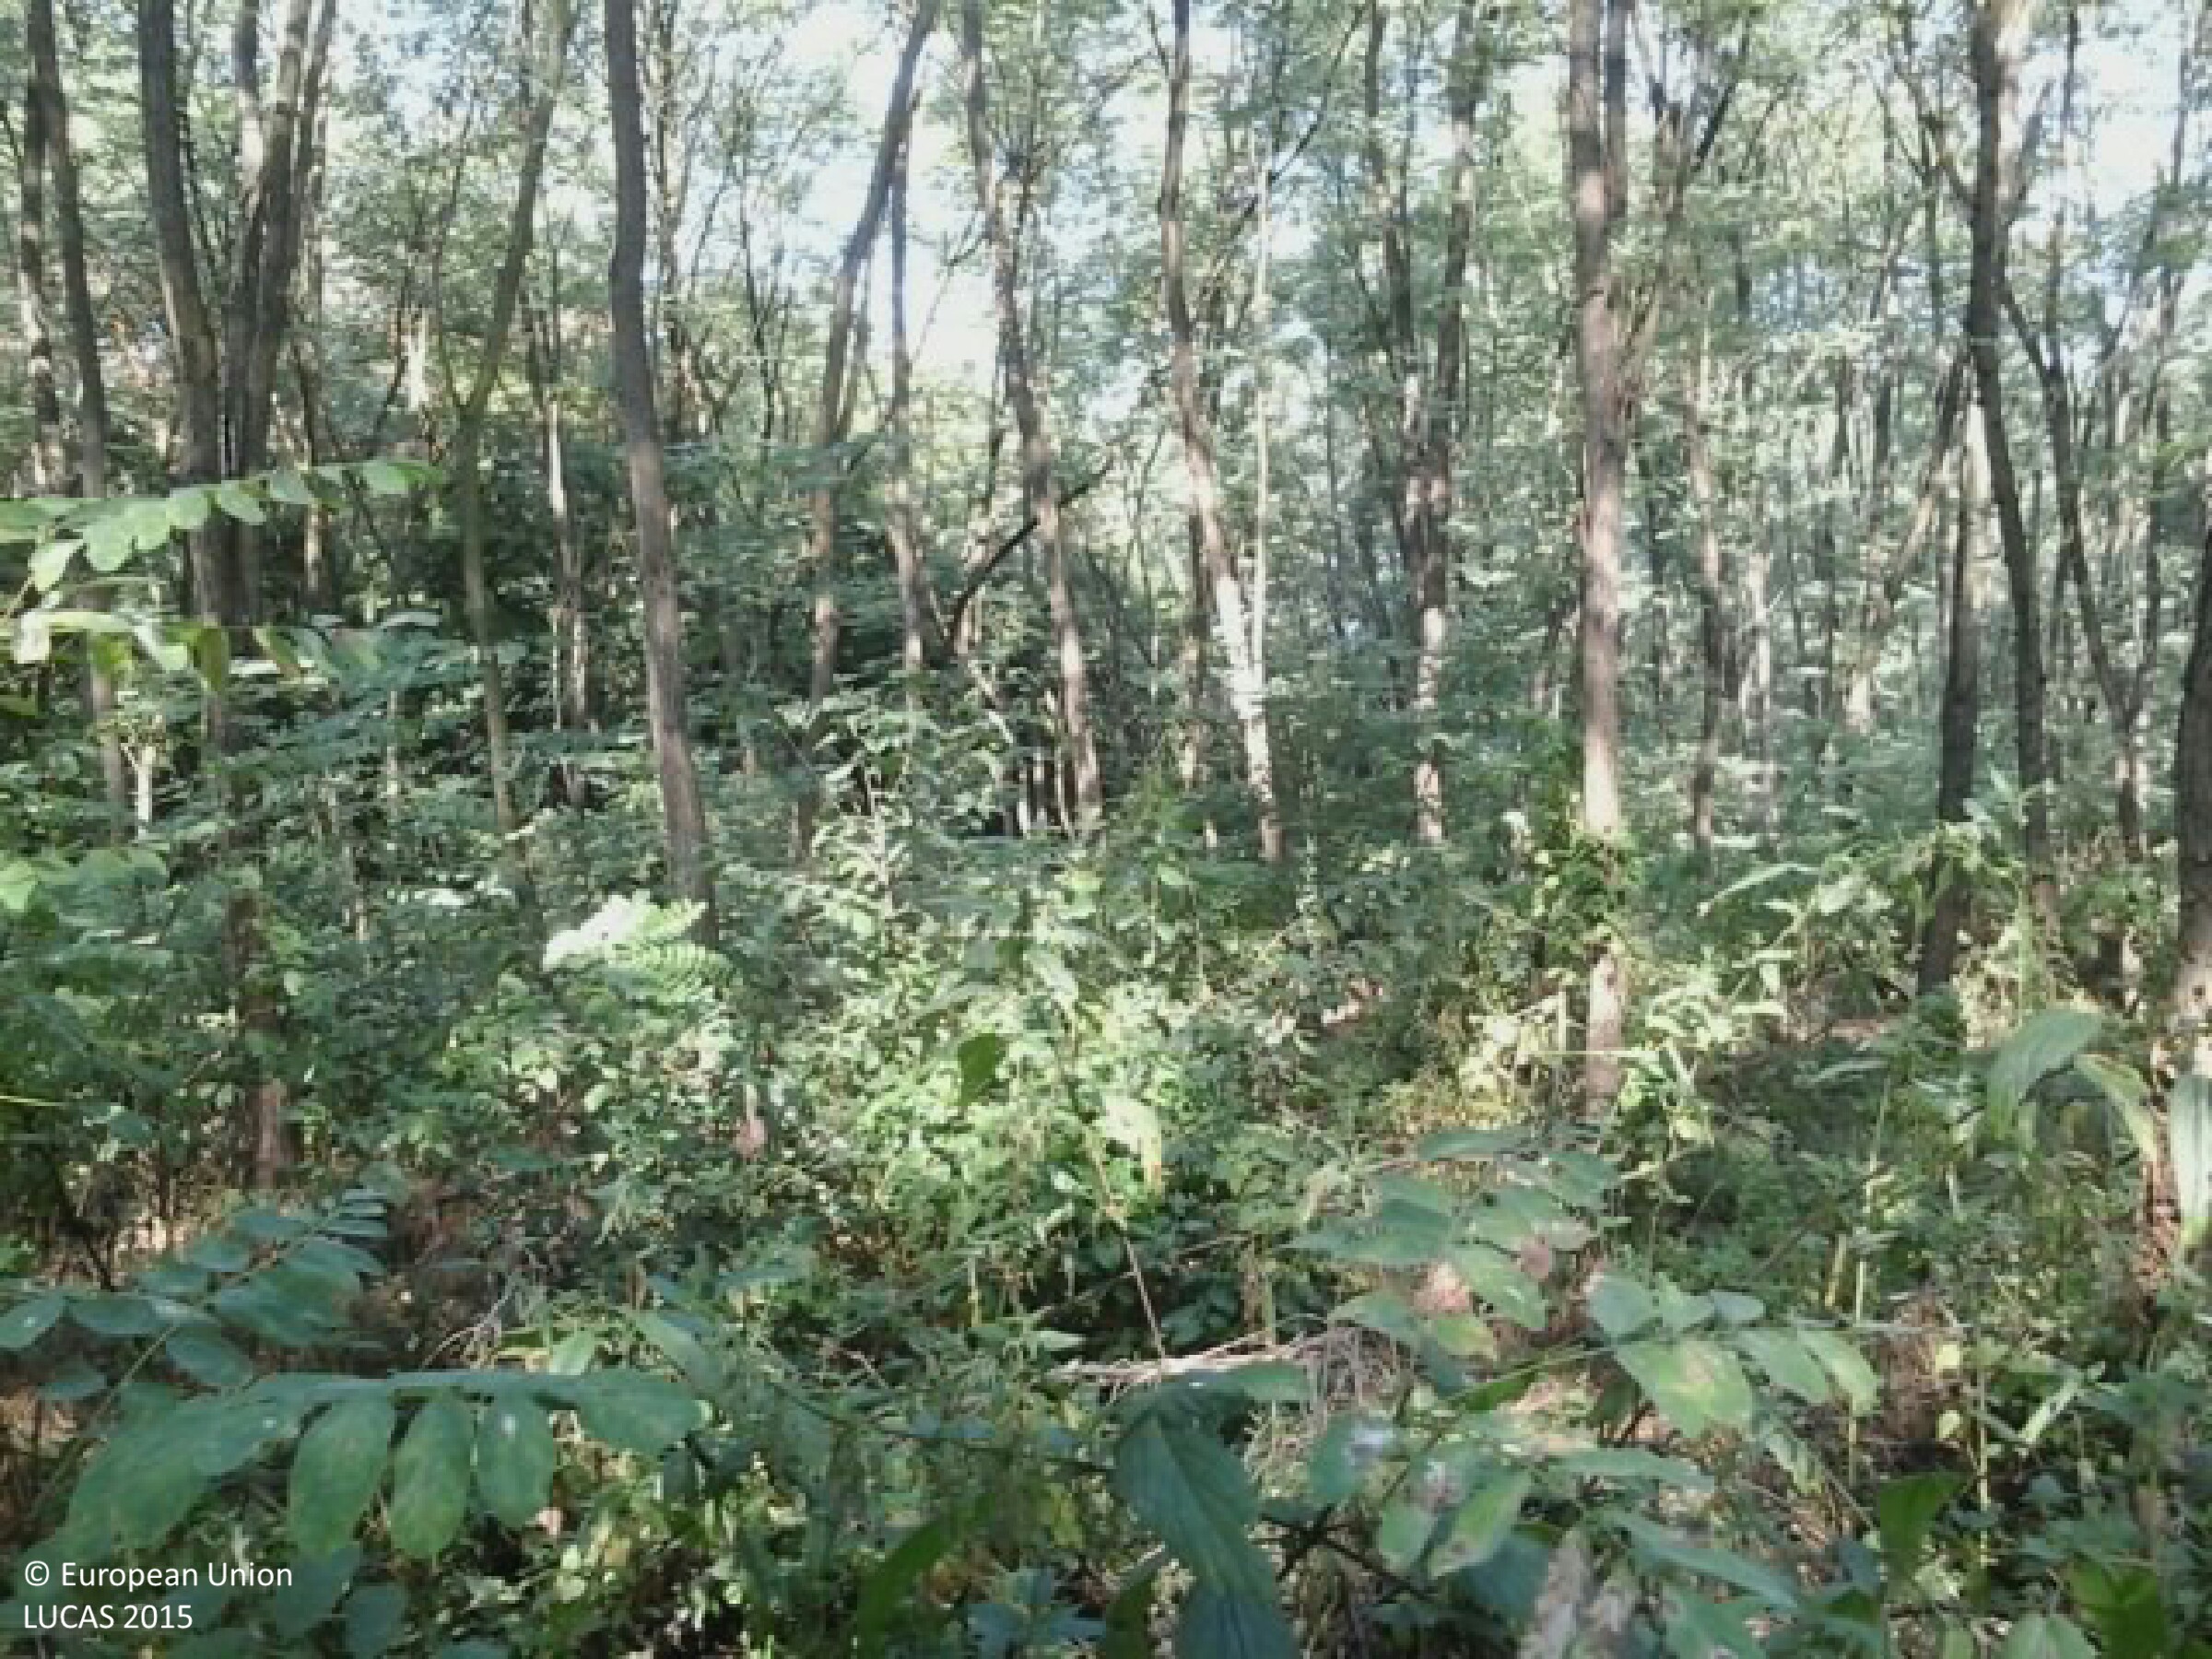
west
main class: Woodland
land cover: Broadleaved woodland
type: mesophytic deciduous forest
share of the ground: > 75 %
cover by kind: broadleaved forest trees 80 %, shrubs 20 %
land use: Forestry
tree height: > 5 m
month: August
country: HU
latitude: 47.2805
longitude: 19.3663
